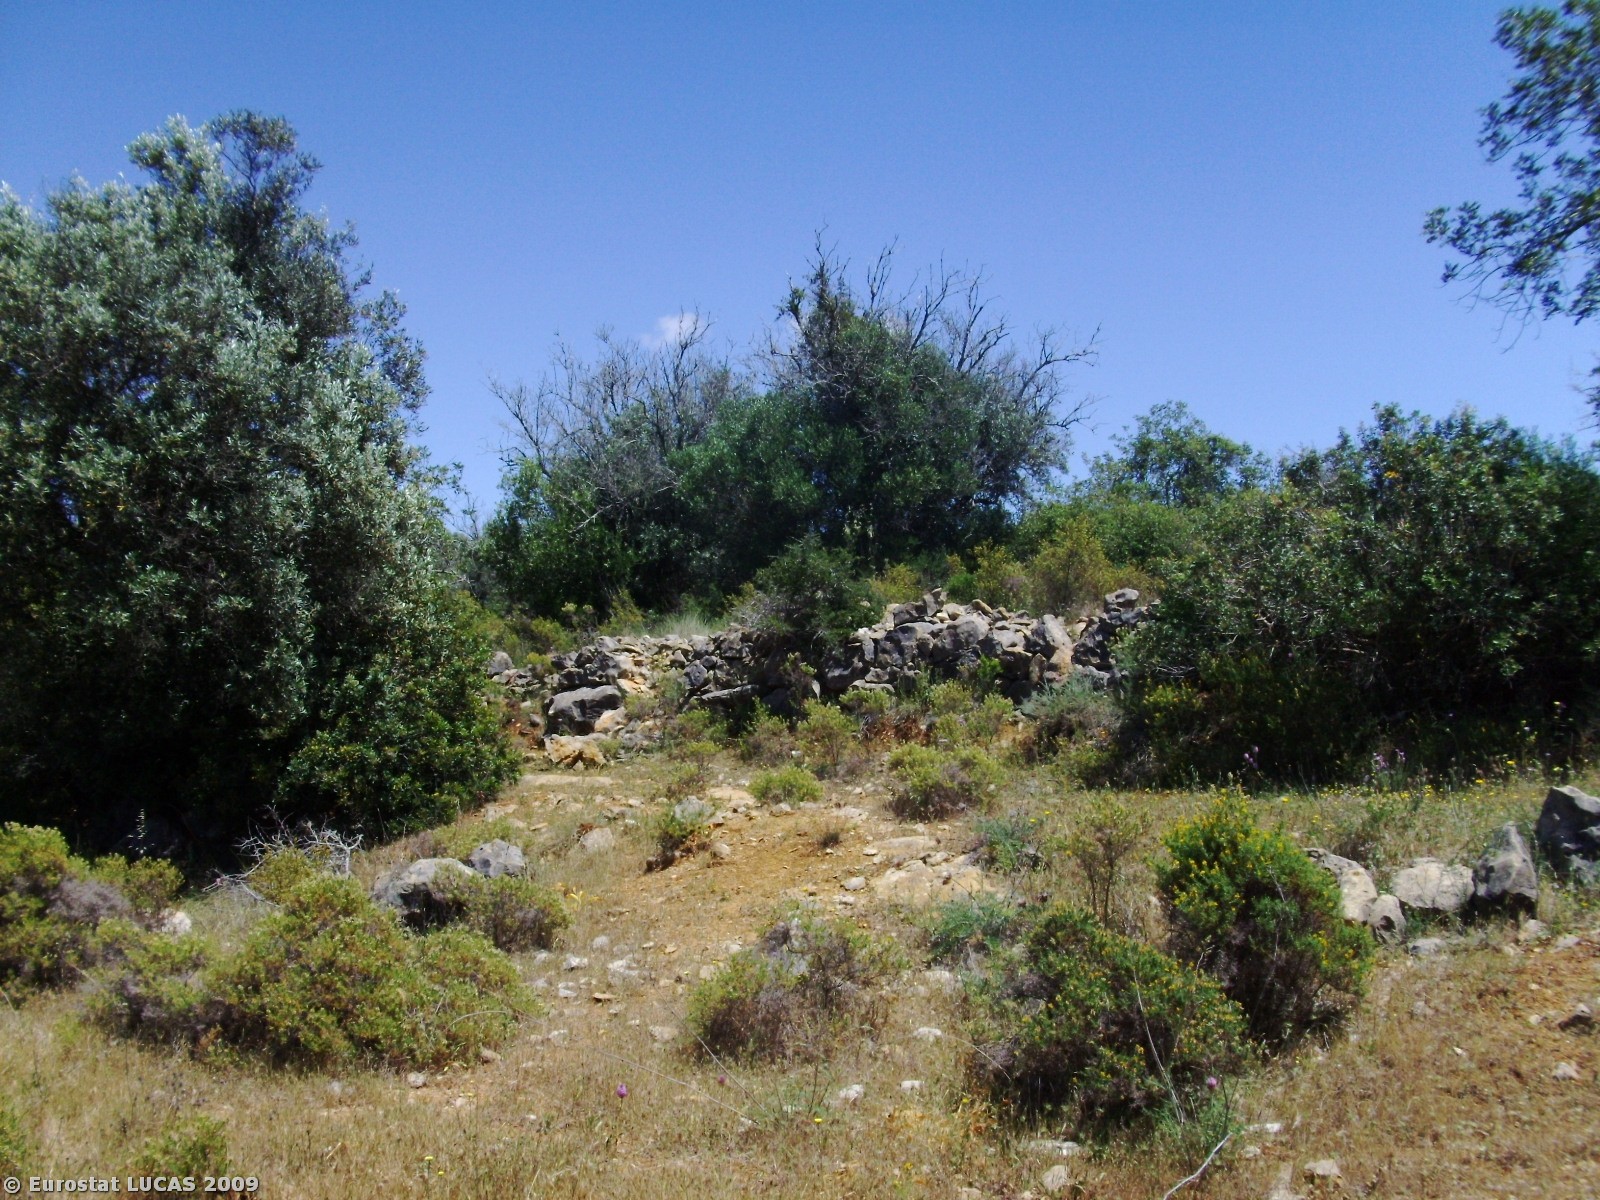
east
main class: Grassland
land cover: Grassland with sparse tree/shrub cover
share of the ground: > 75 %
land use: Fallow land
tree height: > 5 m
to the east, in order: Grassland with sparse tree/shrub cover; Tracks; Shrubland with sparse tree cover; Dry stone walls; Grassland with sparse tree/shrub cover; Dry stone walls; Grassland with sparse tree/shrub cover; Tracks; Dry stone walls; Lines of trees; Grassland with sparse tree/shrub cover; Single bushes/trees; Spontaneously vegetated surfaces
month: May
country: PT
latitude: 37.1432
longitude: -8.3839
